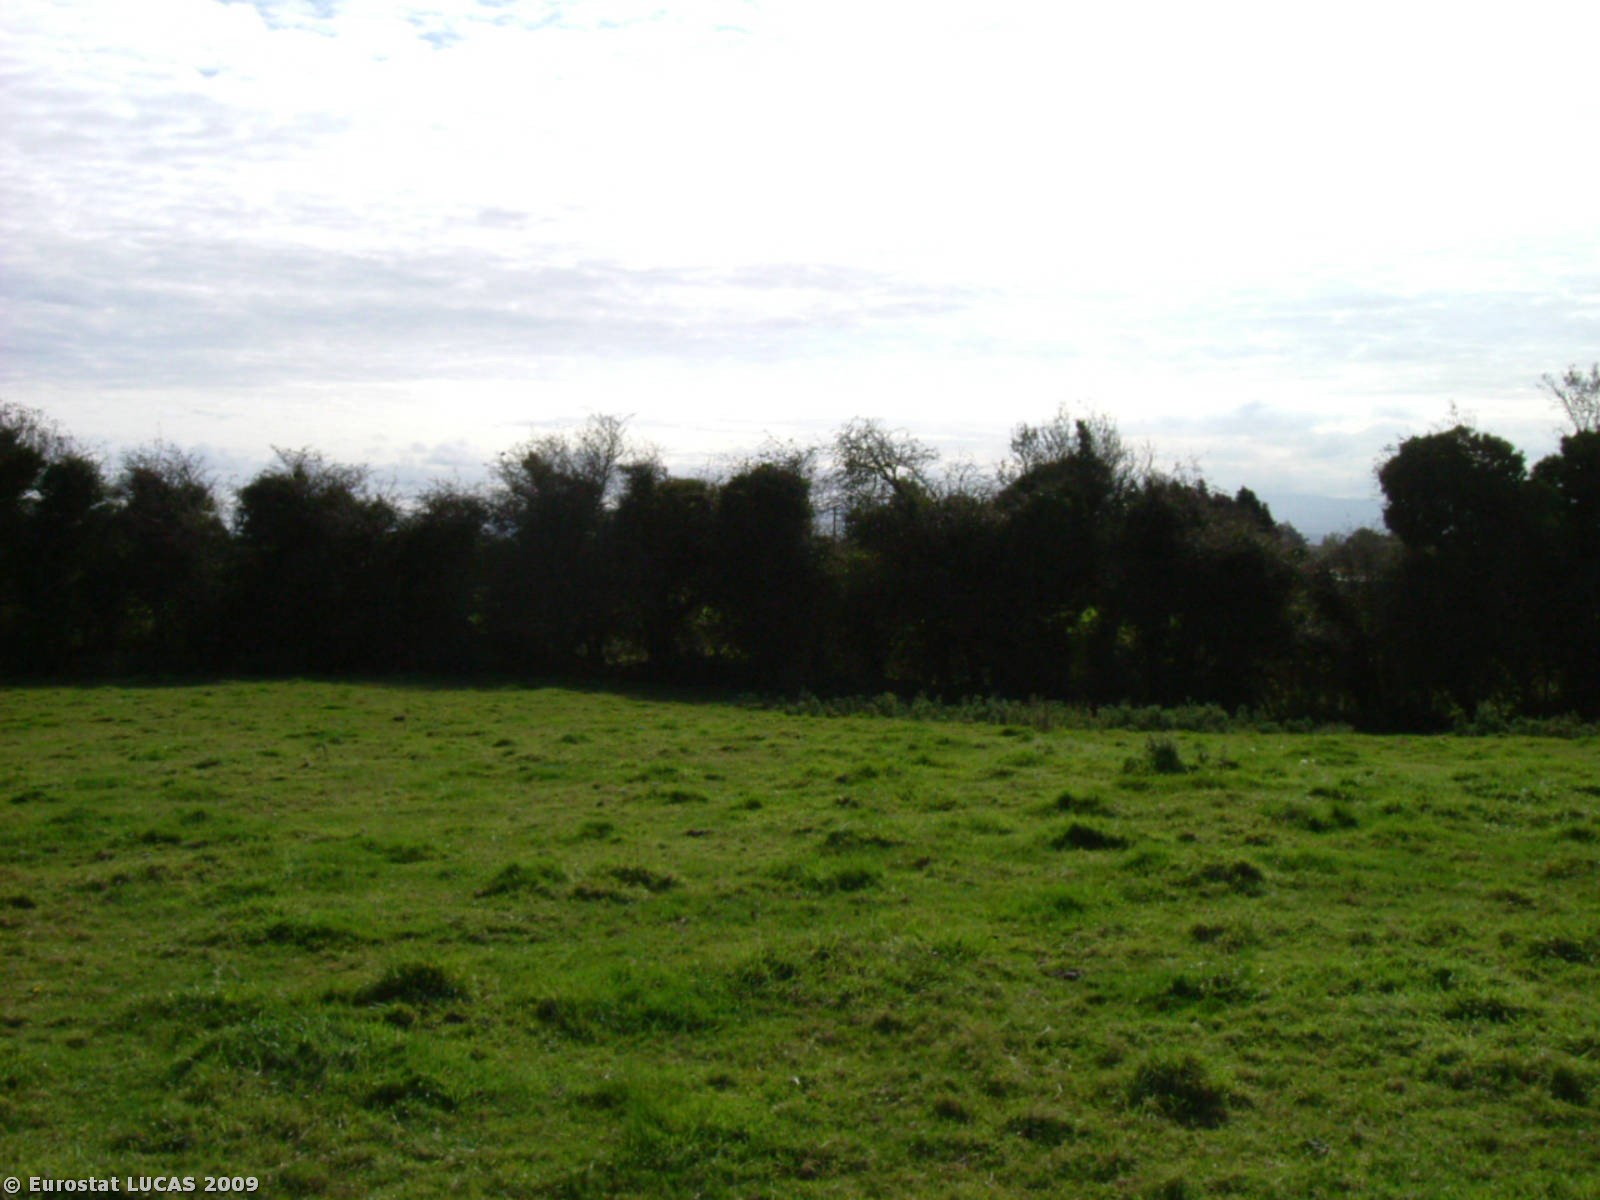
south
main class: Grassland
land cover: Grassland without tree/shrub cover
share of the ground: > 75 %
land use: Agriculture (excluding fallow land and kitchen gardens)
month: October
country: IE
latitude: 52.5558
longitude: -8.1002
